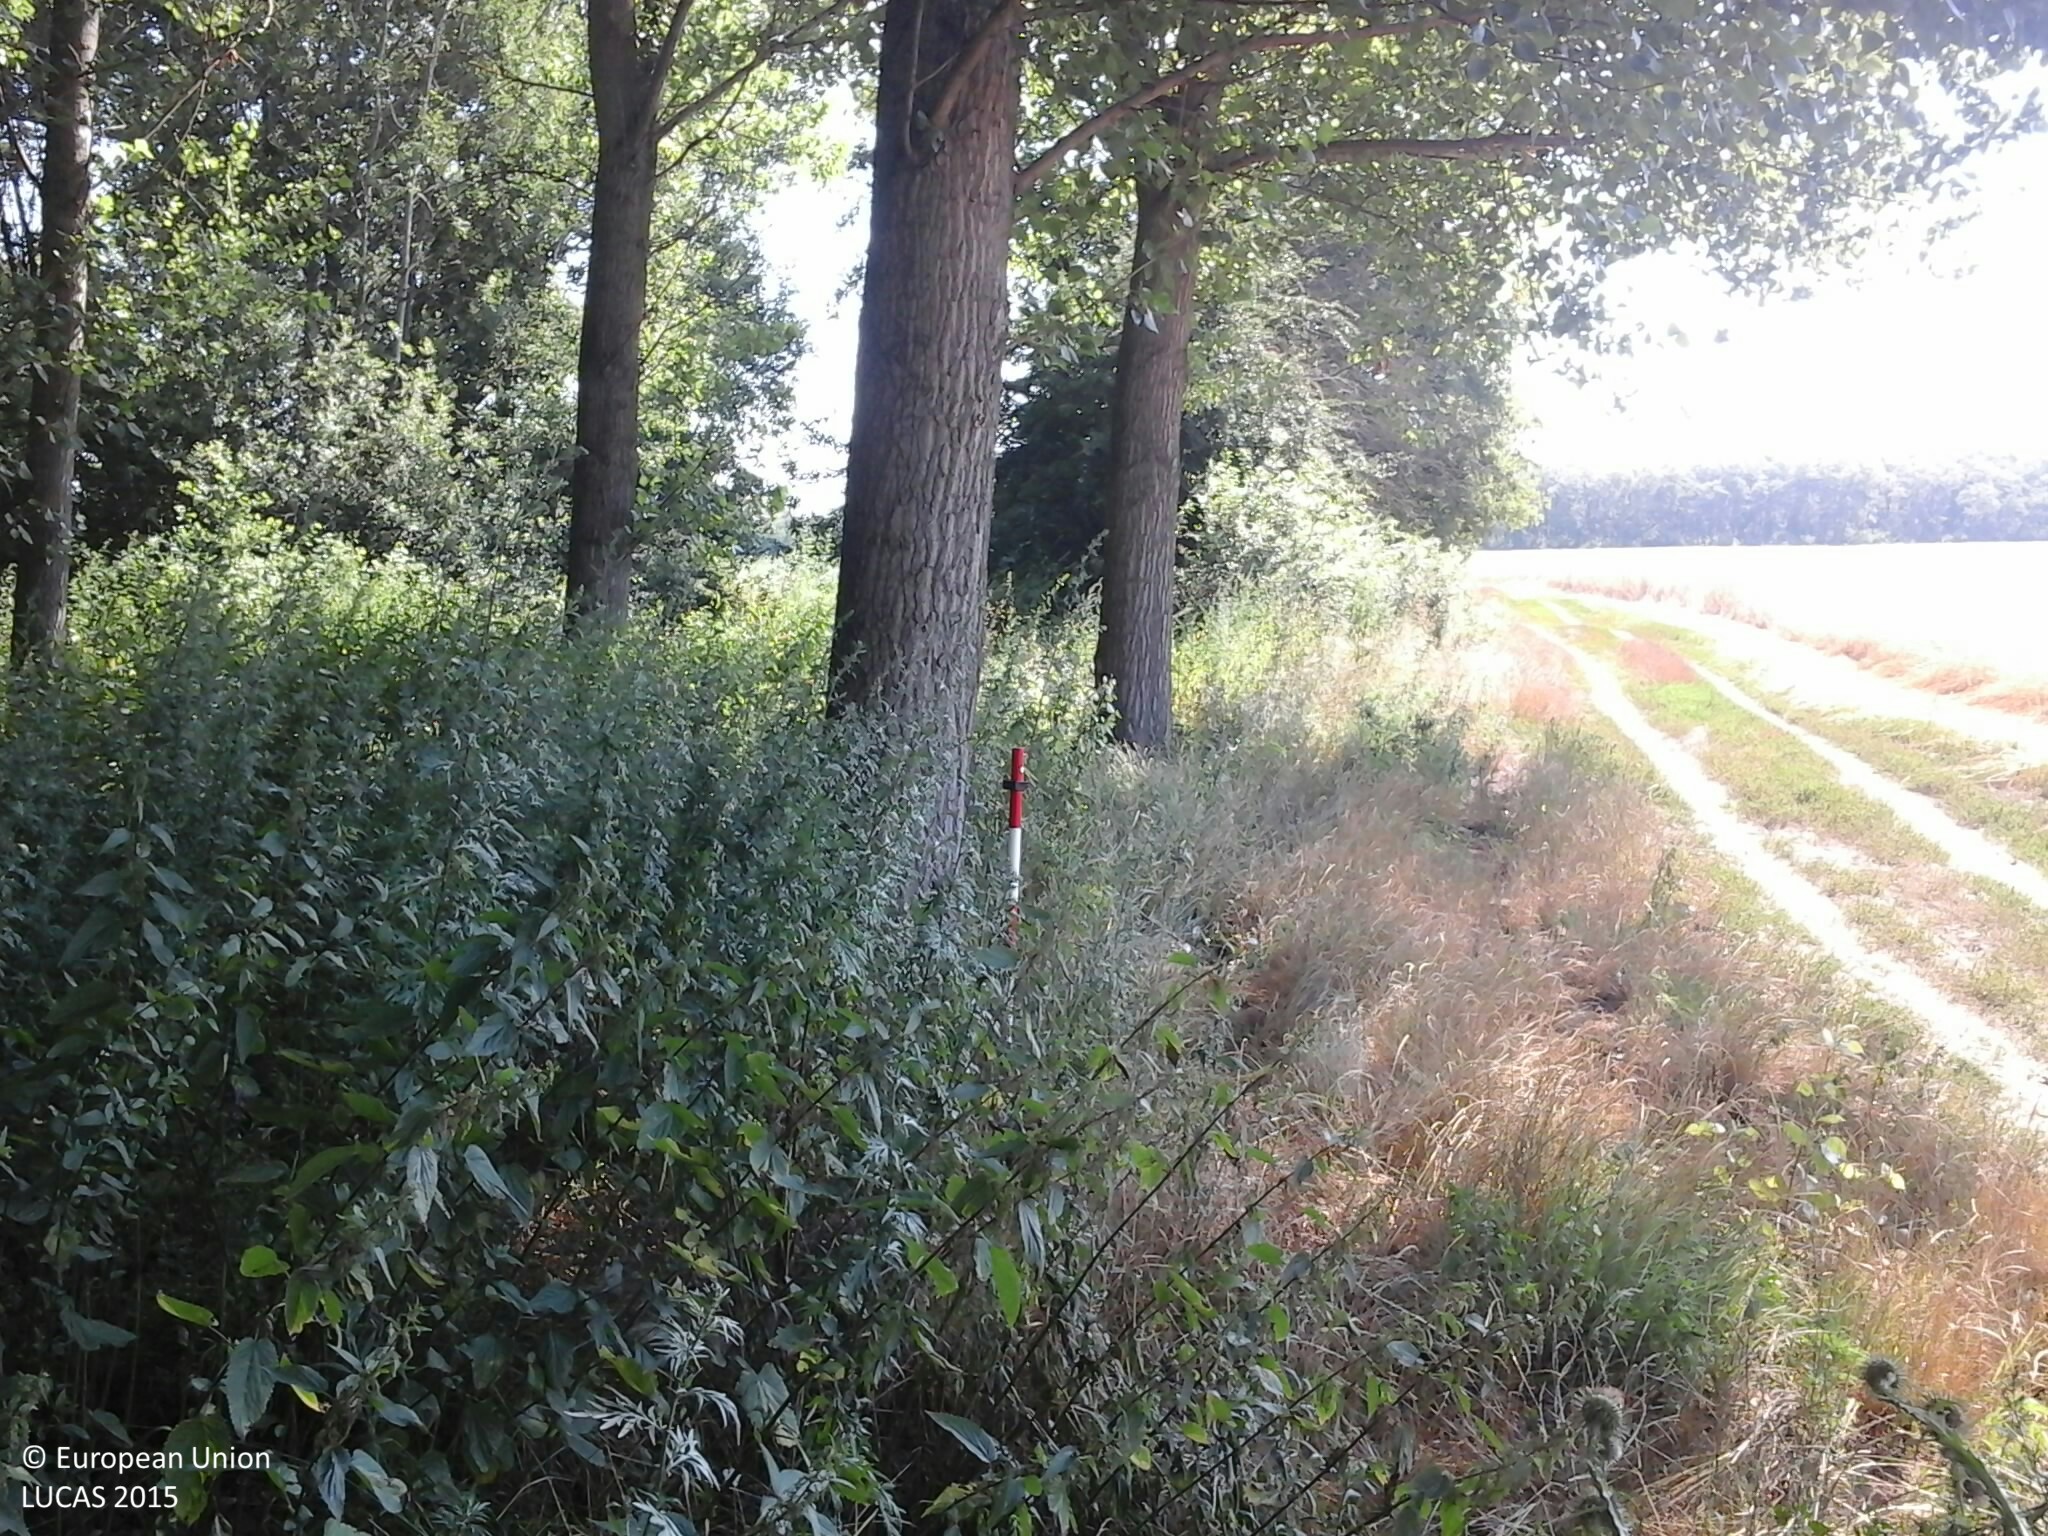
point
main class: Woodland
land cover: Broadleaved woodland
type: mesophytic deciduous forest
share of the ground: > 75 %
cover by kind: broadleaved forest trees 95 %, herbaceous plants 5 %
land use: Forestry
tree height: > 5 m
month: July
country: HU
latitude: 47.7959
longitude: 22.2162
